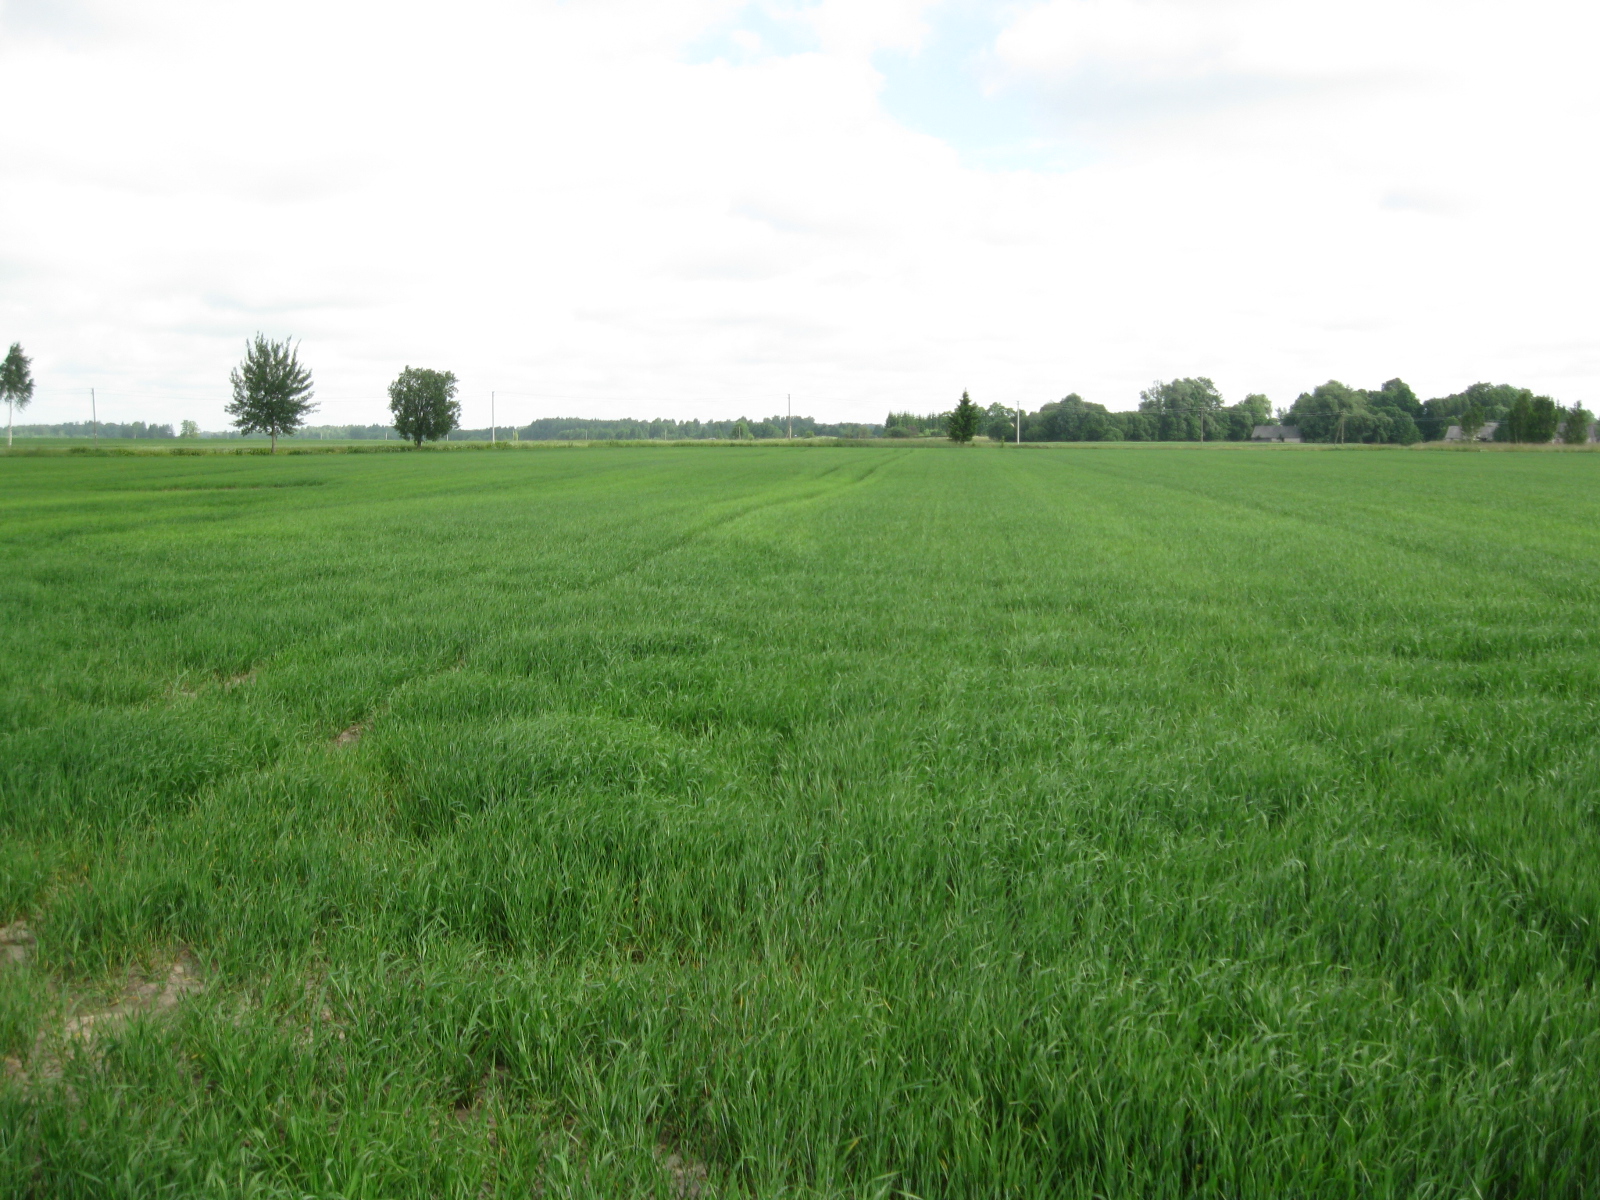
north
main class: Cropland
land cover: Barley
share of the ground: > 75 %
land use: Agriculture (excluding fallow land and kitchen gardens)
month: June
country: LT
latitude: 56.1885
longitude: 24.9152
